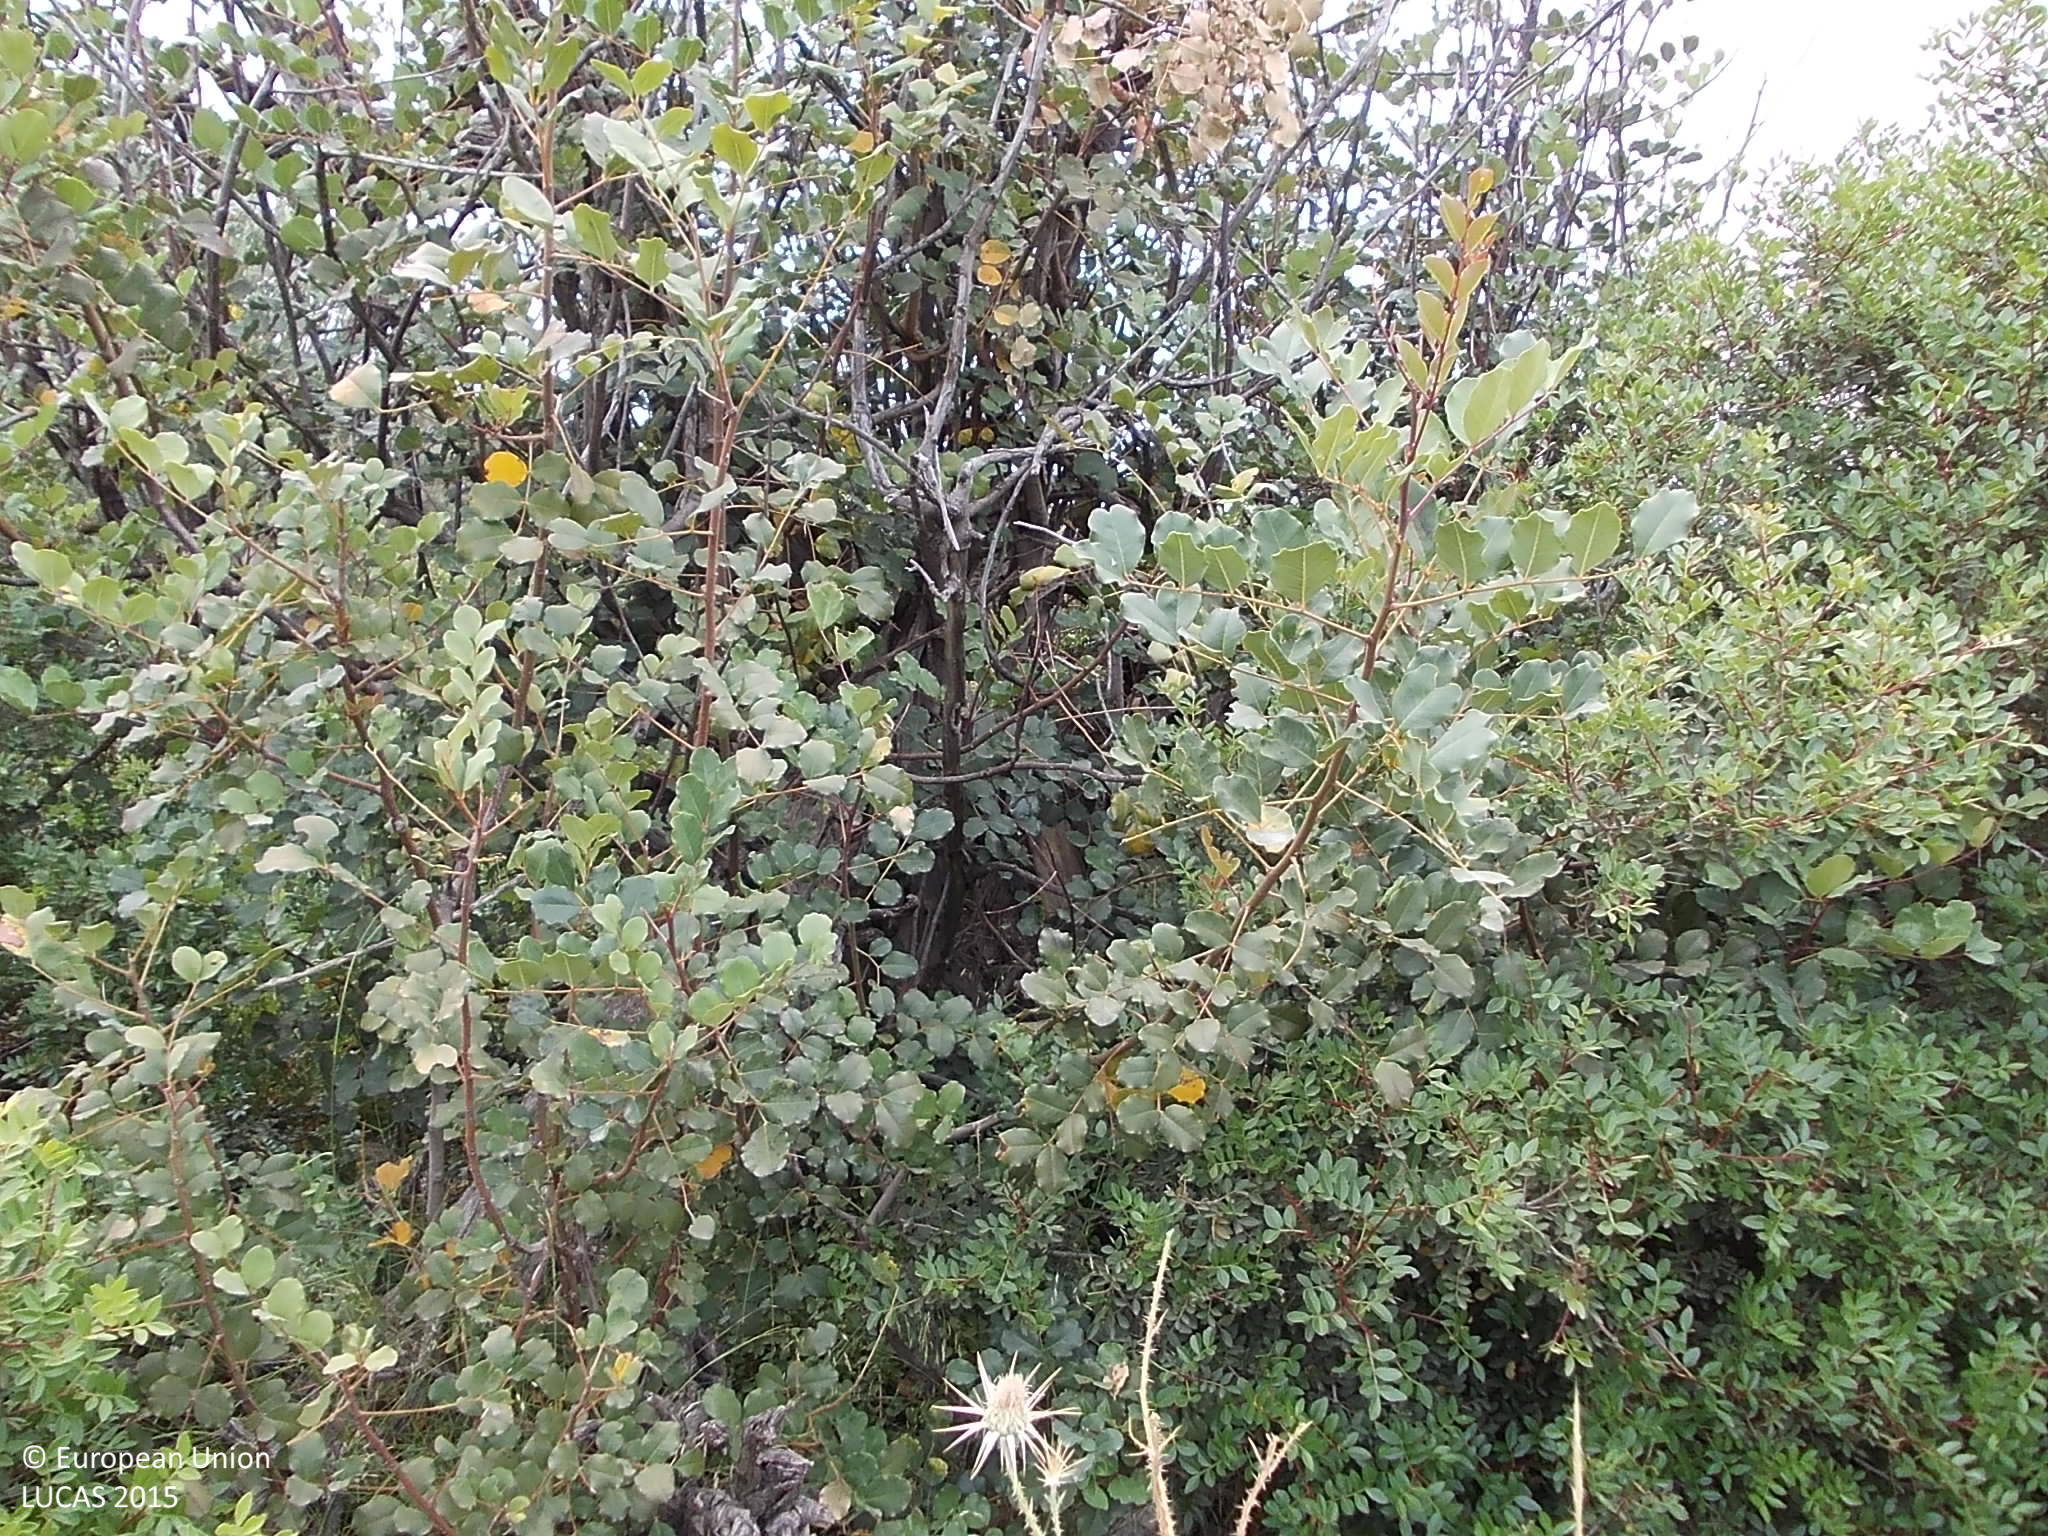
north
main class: Shrubland
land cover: Shrubland with sparse tree cover
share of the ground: > 75 %
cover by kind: shrubs 95 %, broadleaved forest trees 5 %
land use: Semi-natural and natural areas not in use
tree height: < 5 m
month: May
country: CY
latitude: 34.7158
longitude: 32.7917
